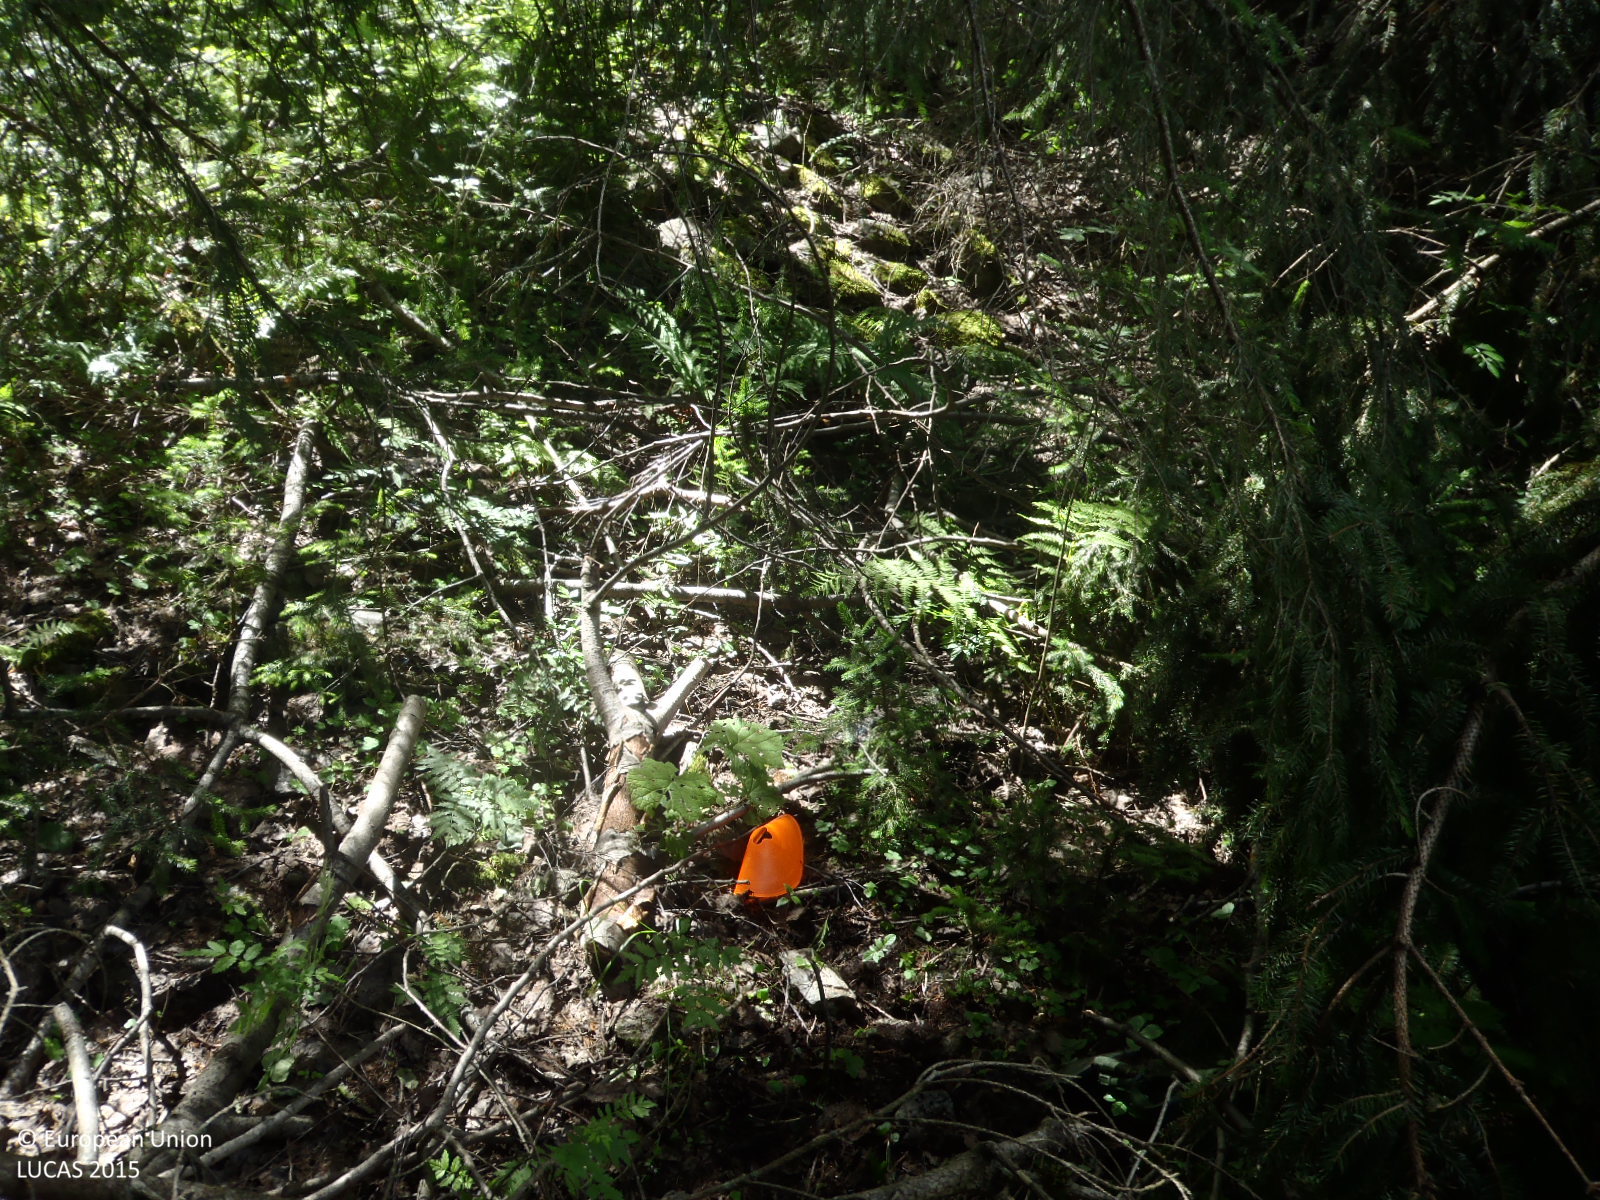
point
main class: Woodland
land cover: Spruce dominated mixed woodland
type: alpine coniferous forest
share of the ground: > 75 %
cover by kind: coniferous forest trees 75 %, broadleaved forest trees 25 %
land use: Forestry
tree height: > 5 m
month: June
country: AT
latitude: 47.1246
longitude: 10.4609
